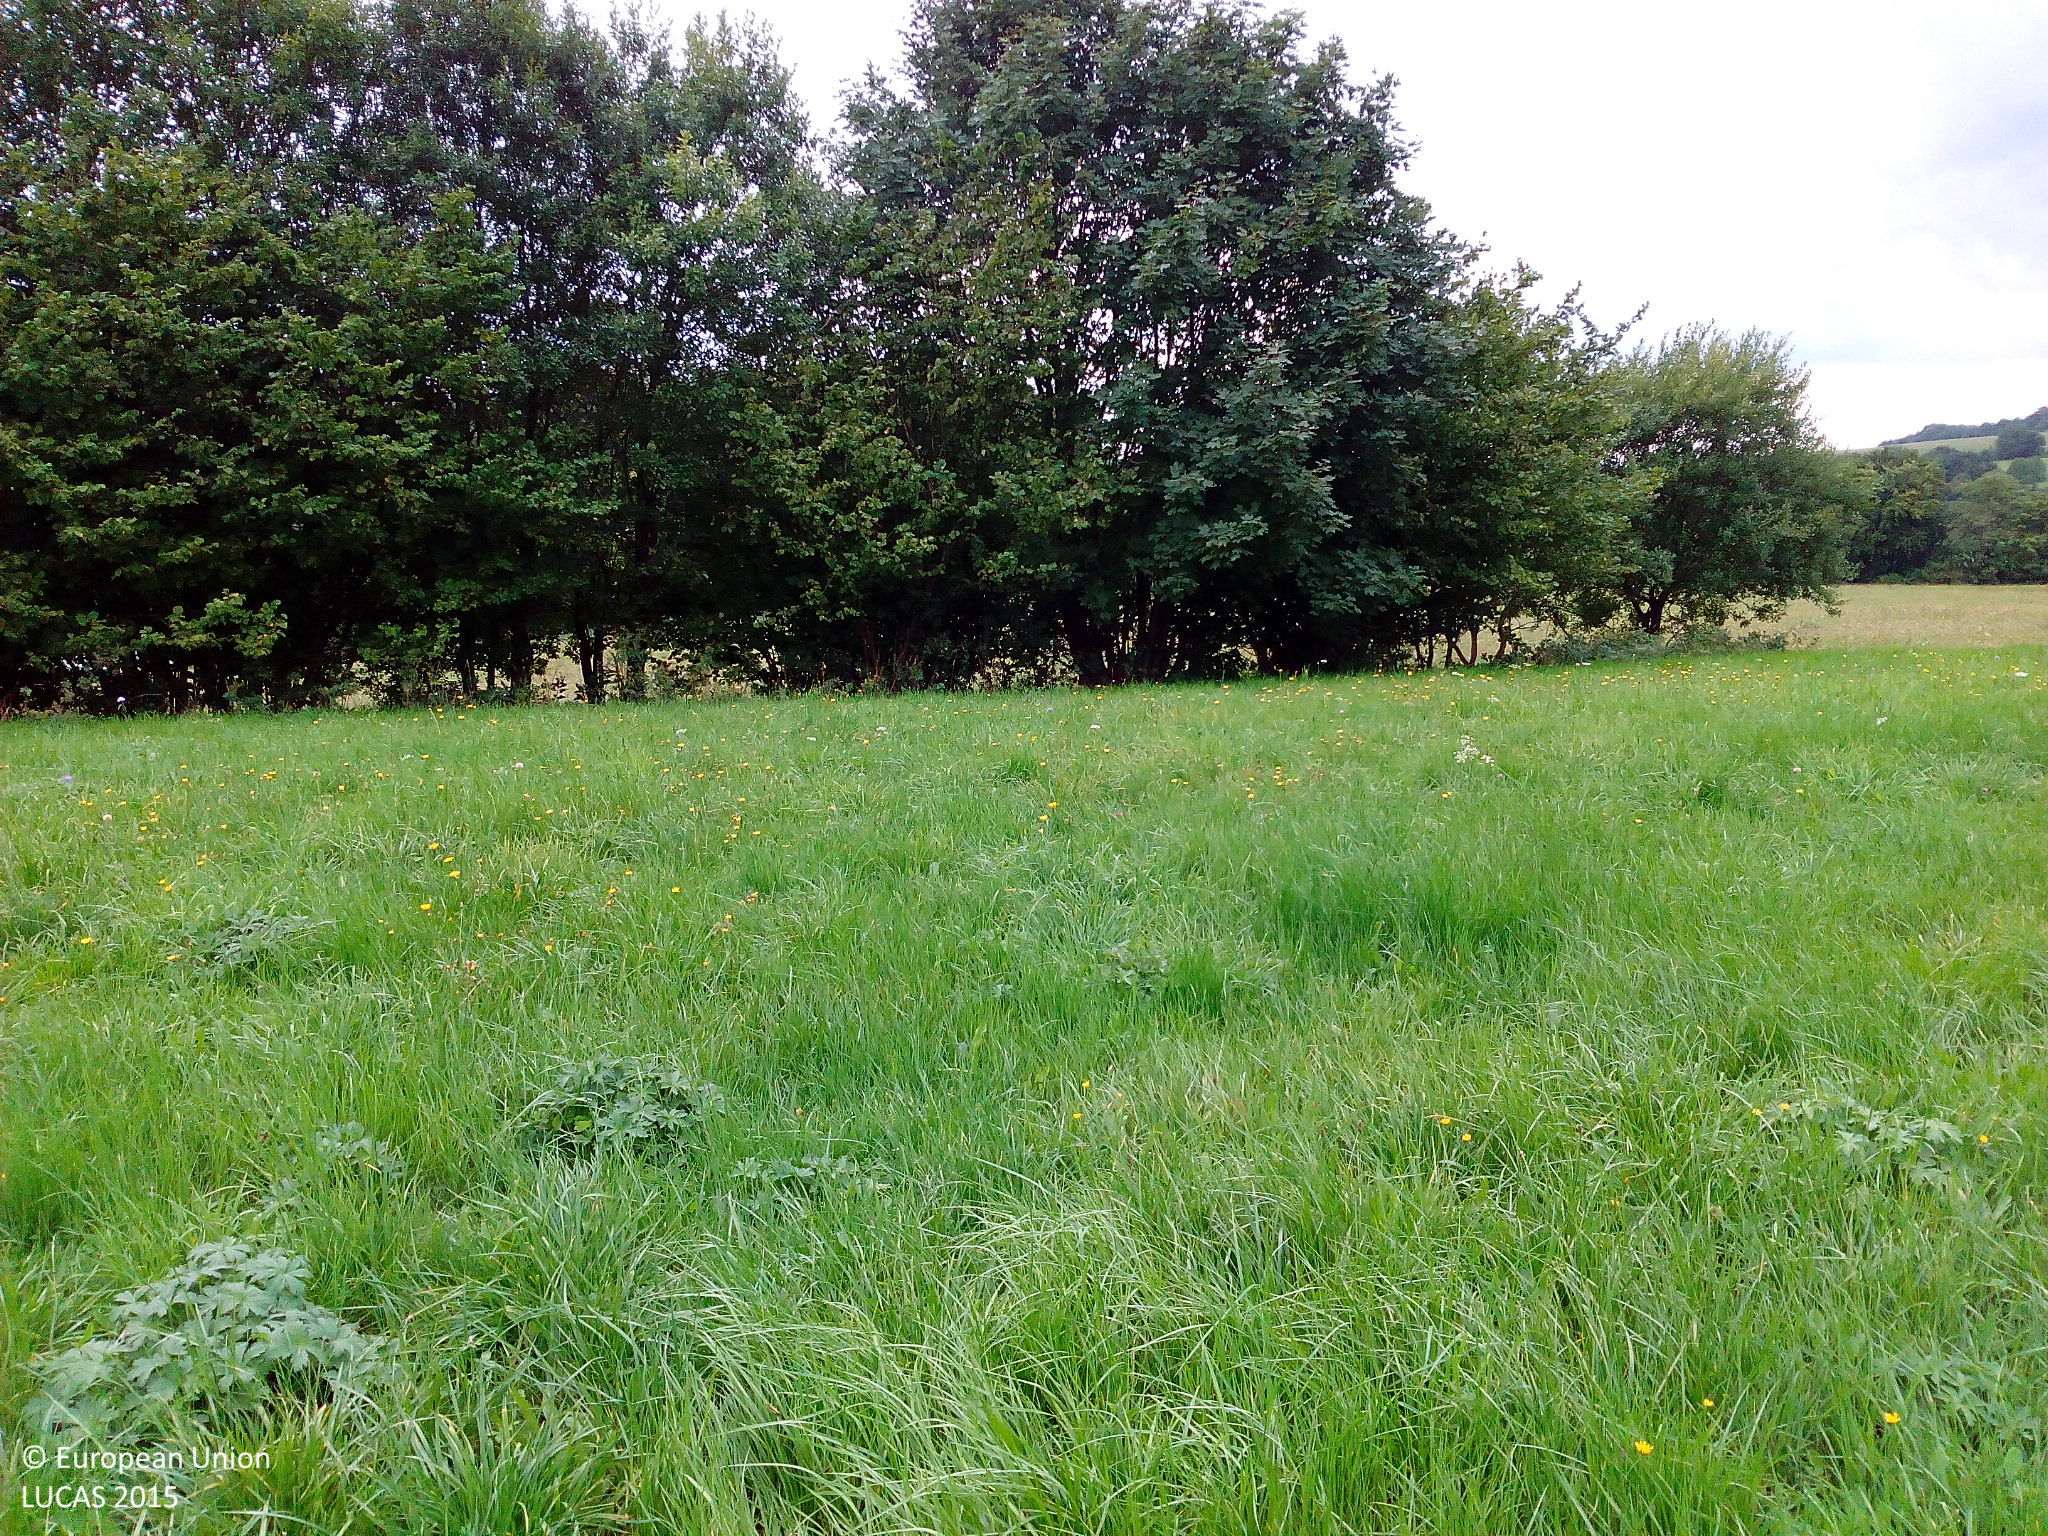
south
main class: Grassland
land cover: Grassland without tree/shrub cover
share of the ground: > 75 %
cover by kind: herbaceous plants 100 %
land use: Agriculture (excluding fallow land and kitchen gardens)
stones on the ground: < 10 %
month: August
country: DE
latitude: 50.4875
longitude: 9.2532
